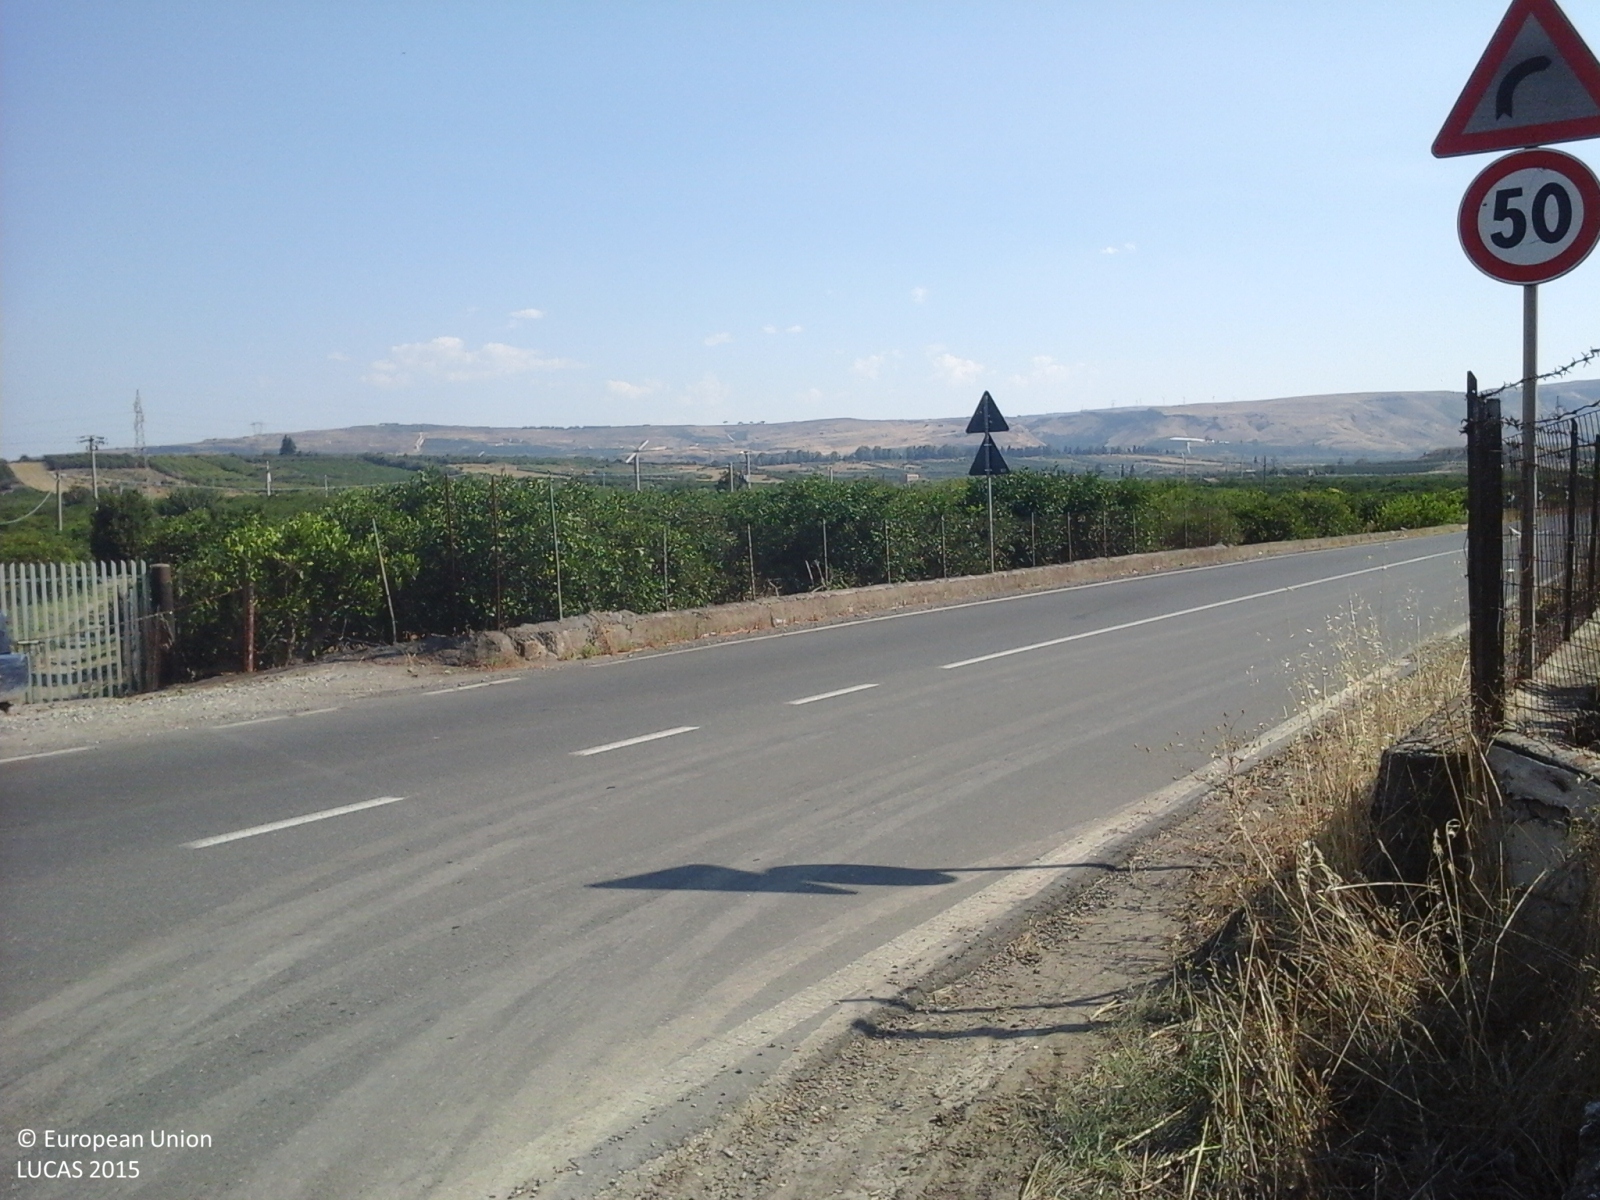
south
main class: Cropland
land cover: Oranges
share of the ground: > 75 %
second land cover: Spontaneously vegetated surfaces
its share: > 75 %
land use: Agriculture (excluding fallow land and kitchen gardens)
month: July
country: IT
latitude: 37.3713
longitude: 14.8087
